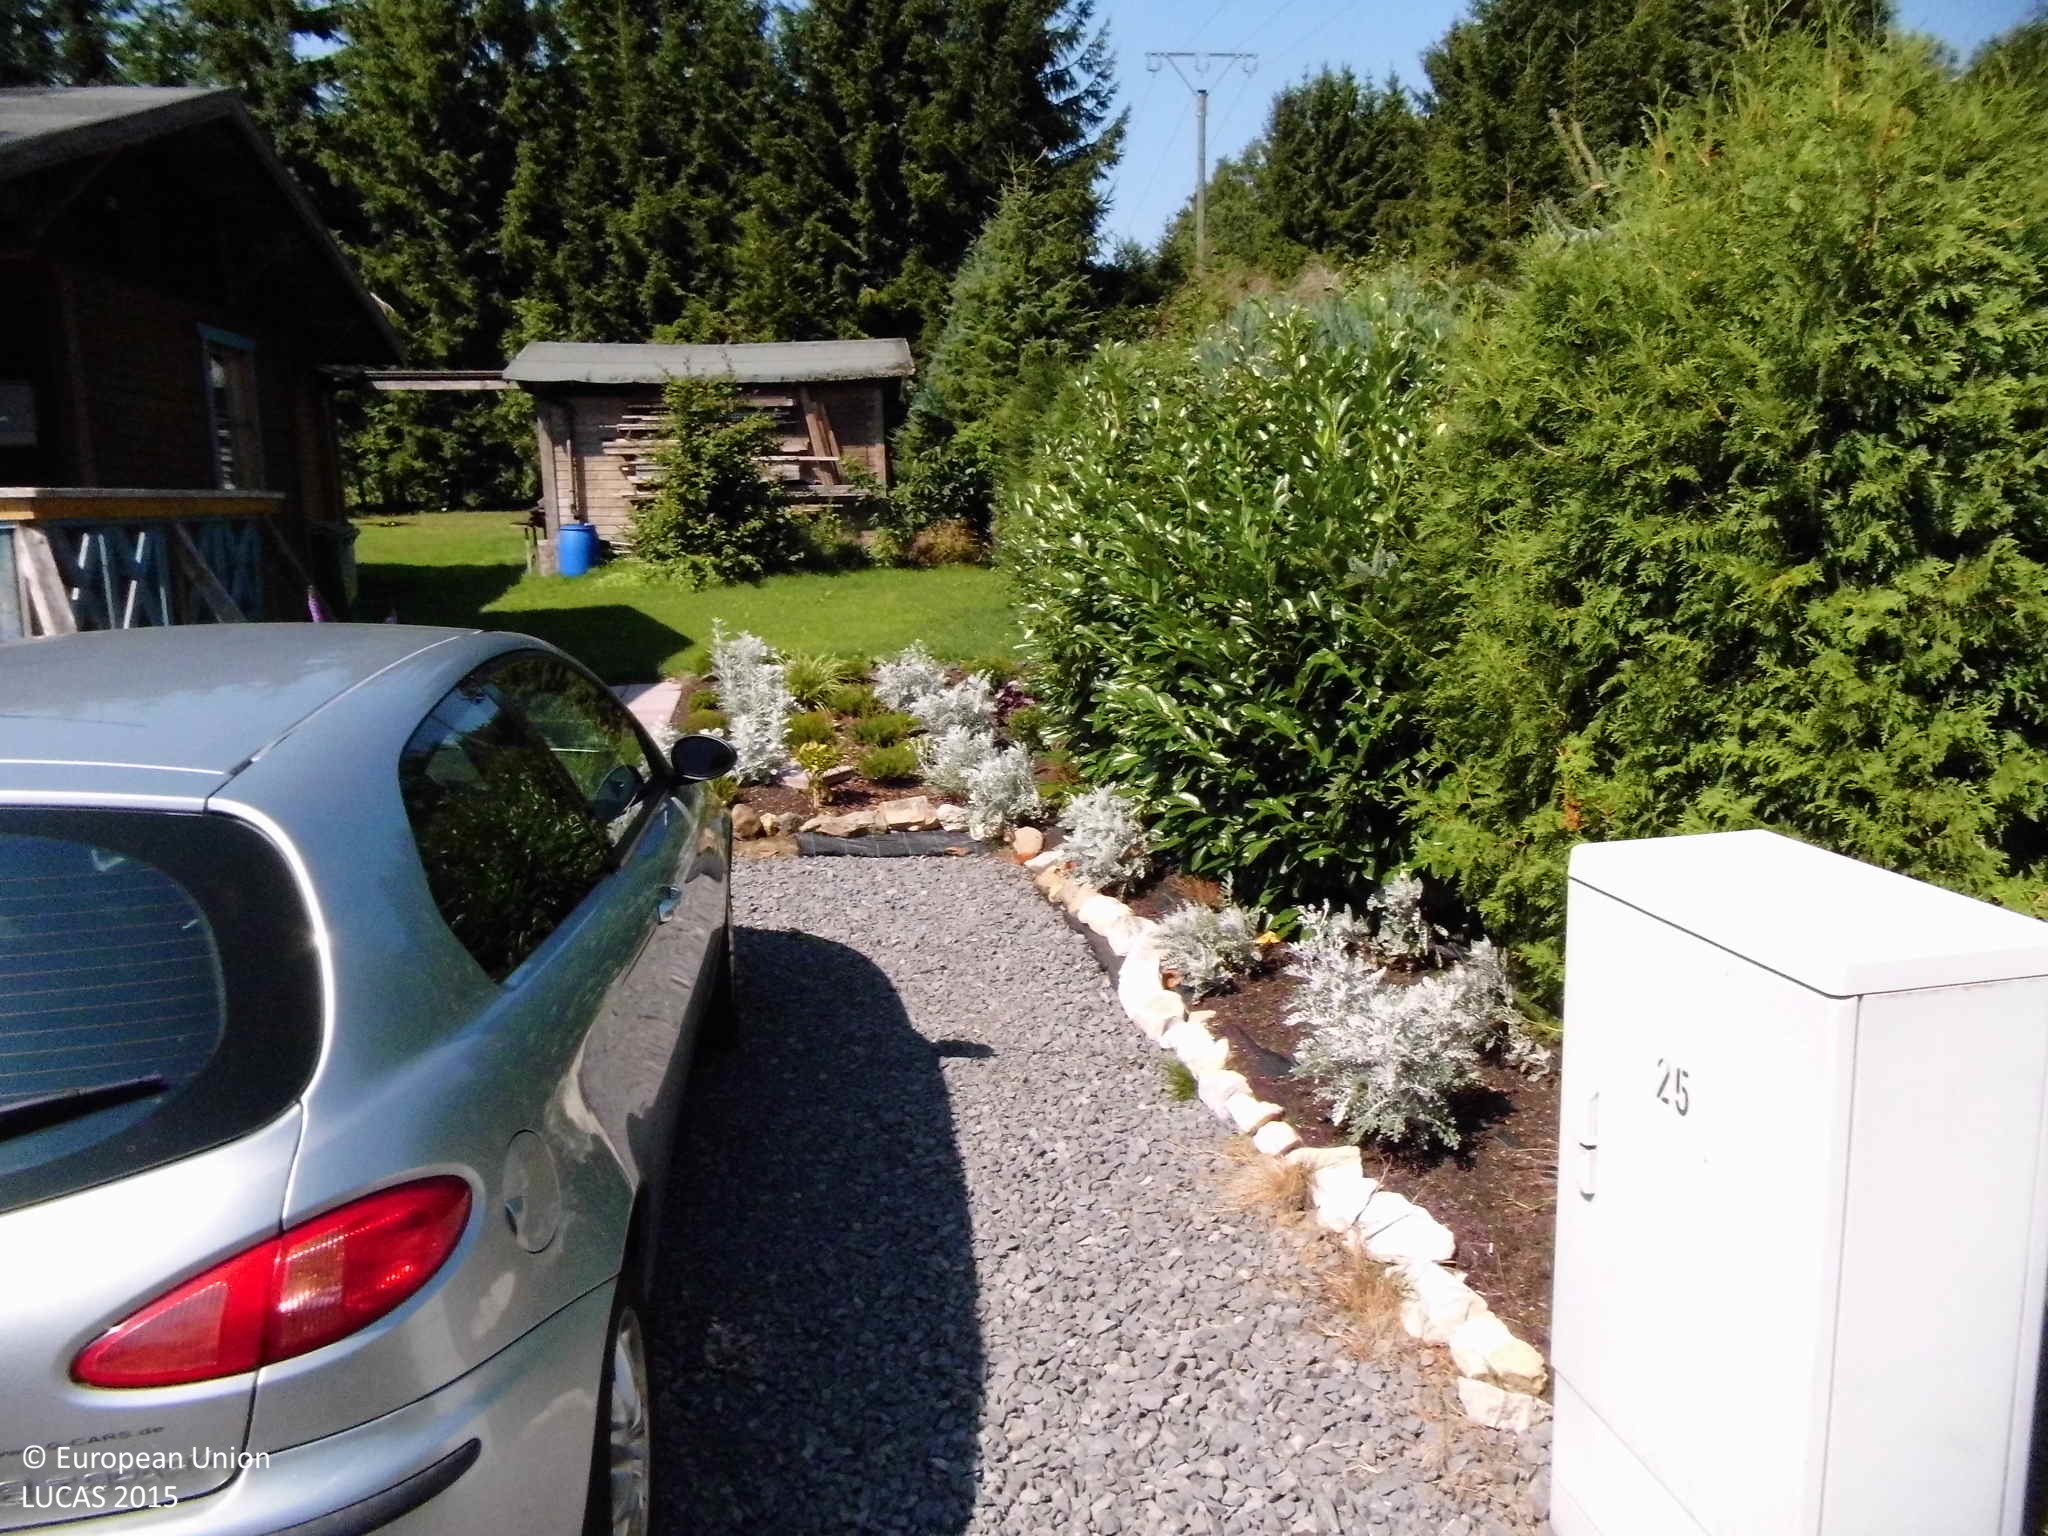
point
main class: Cropland
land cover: Floriculture and ornamental plants
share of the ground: > 75 %
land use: Residential
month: August
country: DE
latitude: 50.6364
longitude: 8.1199
